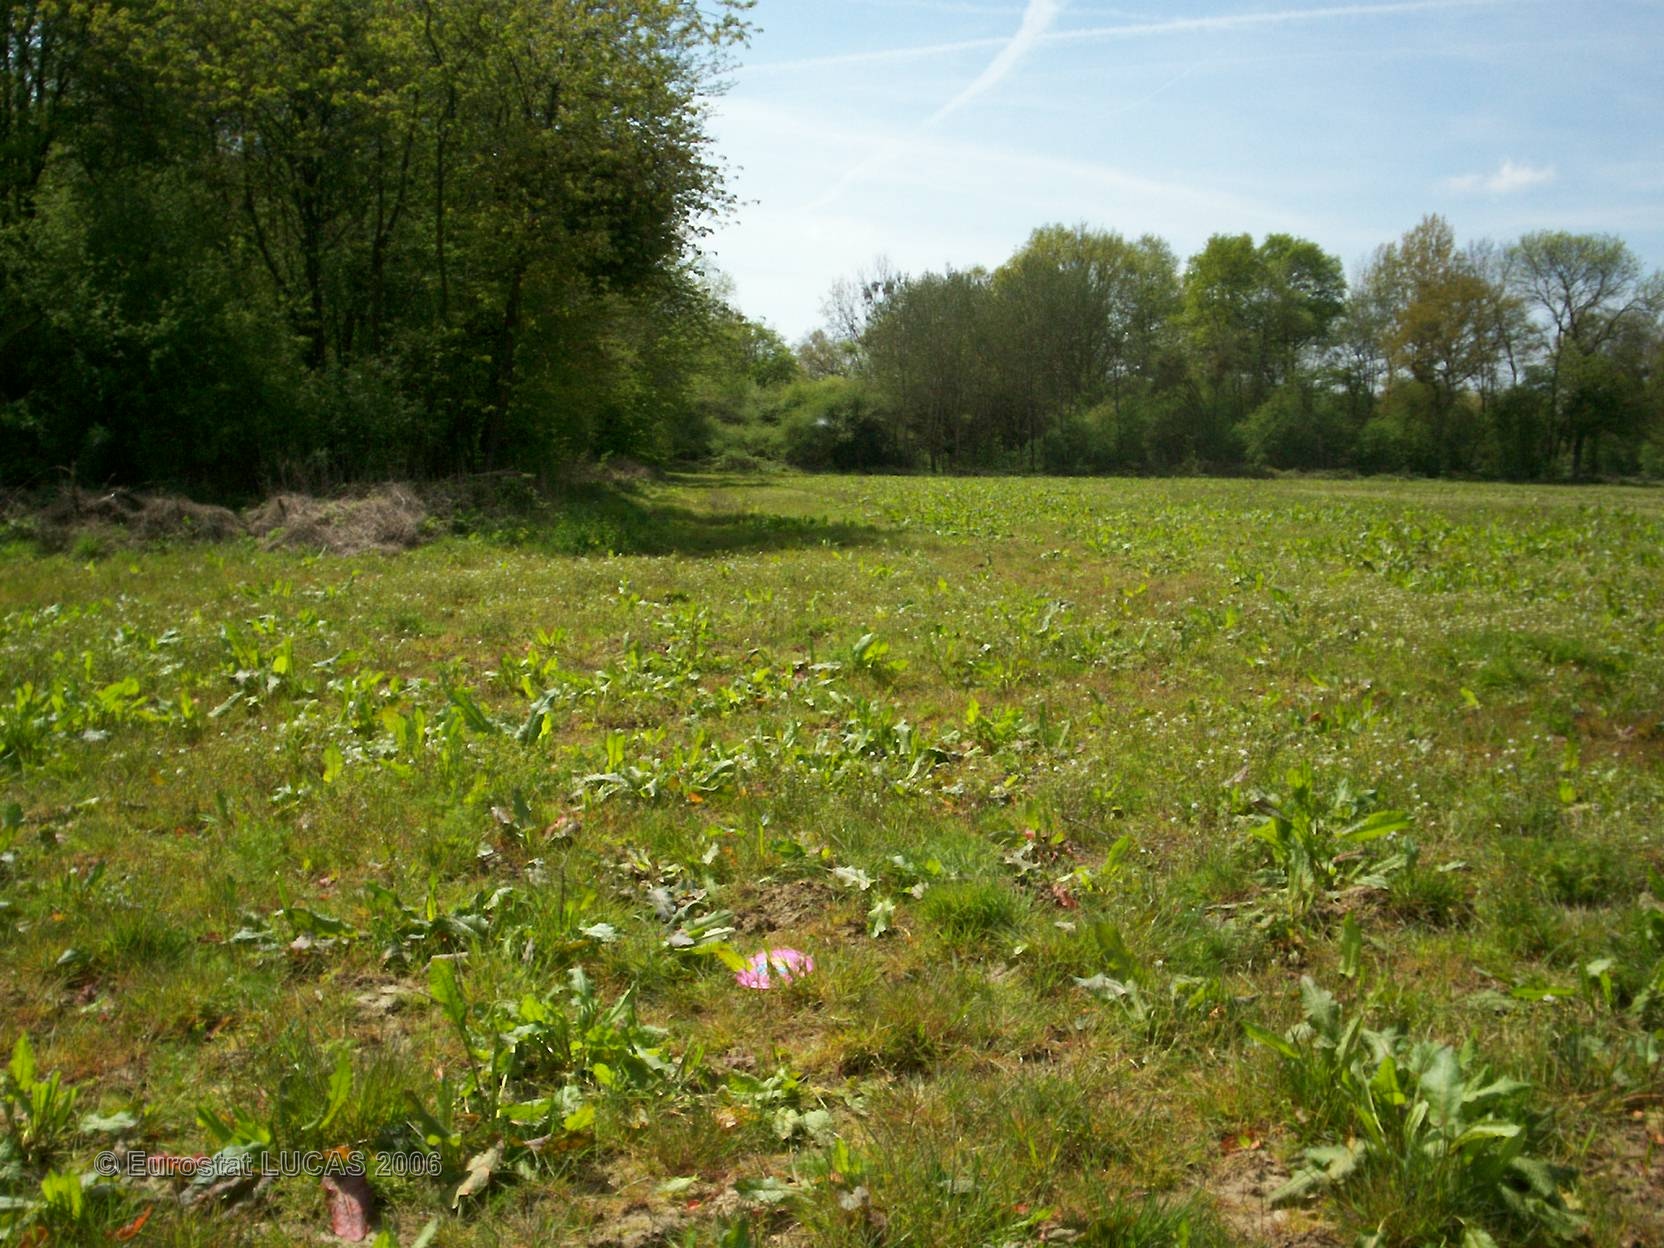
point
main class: Grassland
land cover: Grassland without tree/shrub cover
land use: Agriculture (excluding fallow land and kitchen gardens)
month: May
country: FR
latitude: 48.8197
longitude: 2.8129
